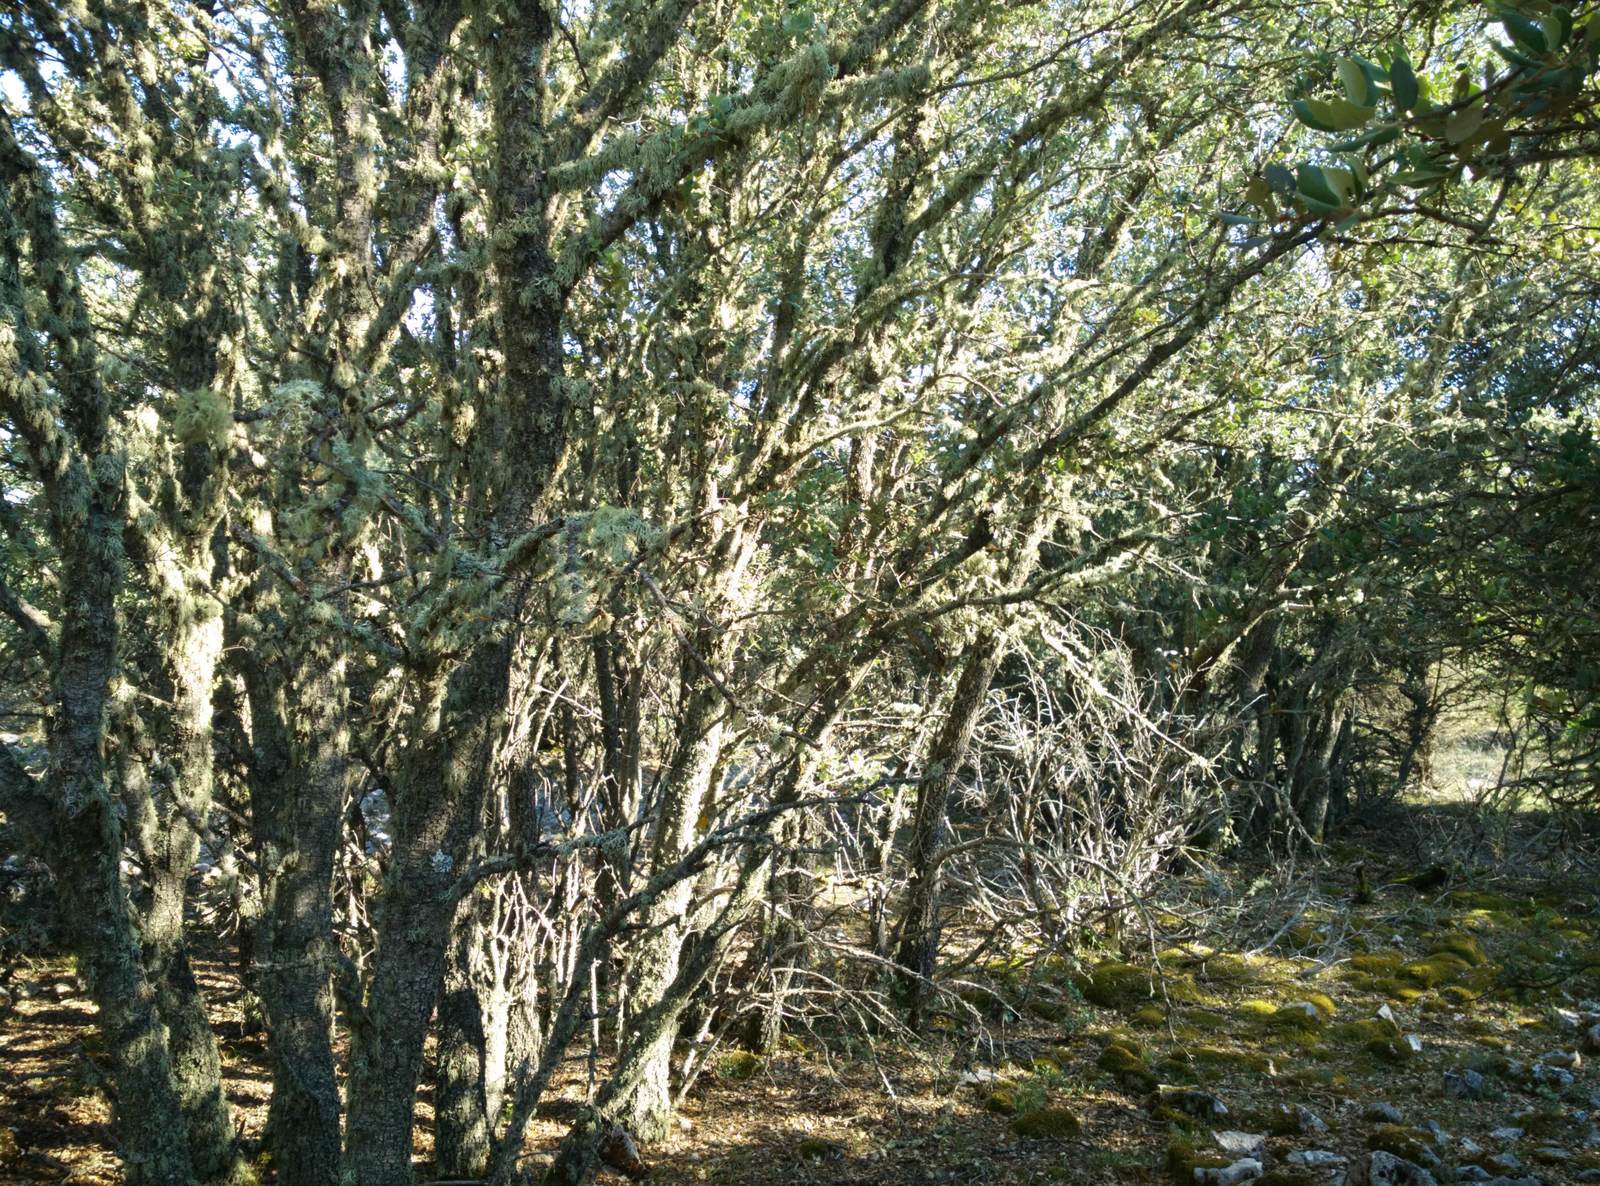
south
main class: Woodland
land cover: Broadleaved woodland
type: broadleaved evergreen forest
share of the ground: 50 - 75 %
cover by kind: broadleaved forest trees 65 %, unconsolidated bare surface 25 %, shrubs 5 %, herbaceous plants 5 %
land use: Semi-natural and natural areas not in use
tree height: > 5 m
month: June
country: ES
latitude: 40.7184
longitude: -1.8230
